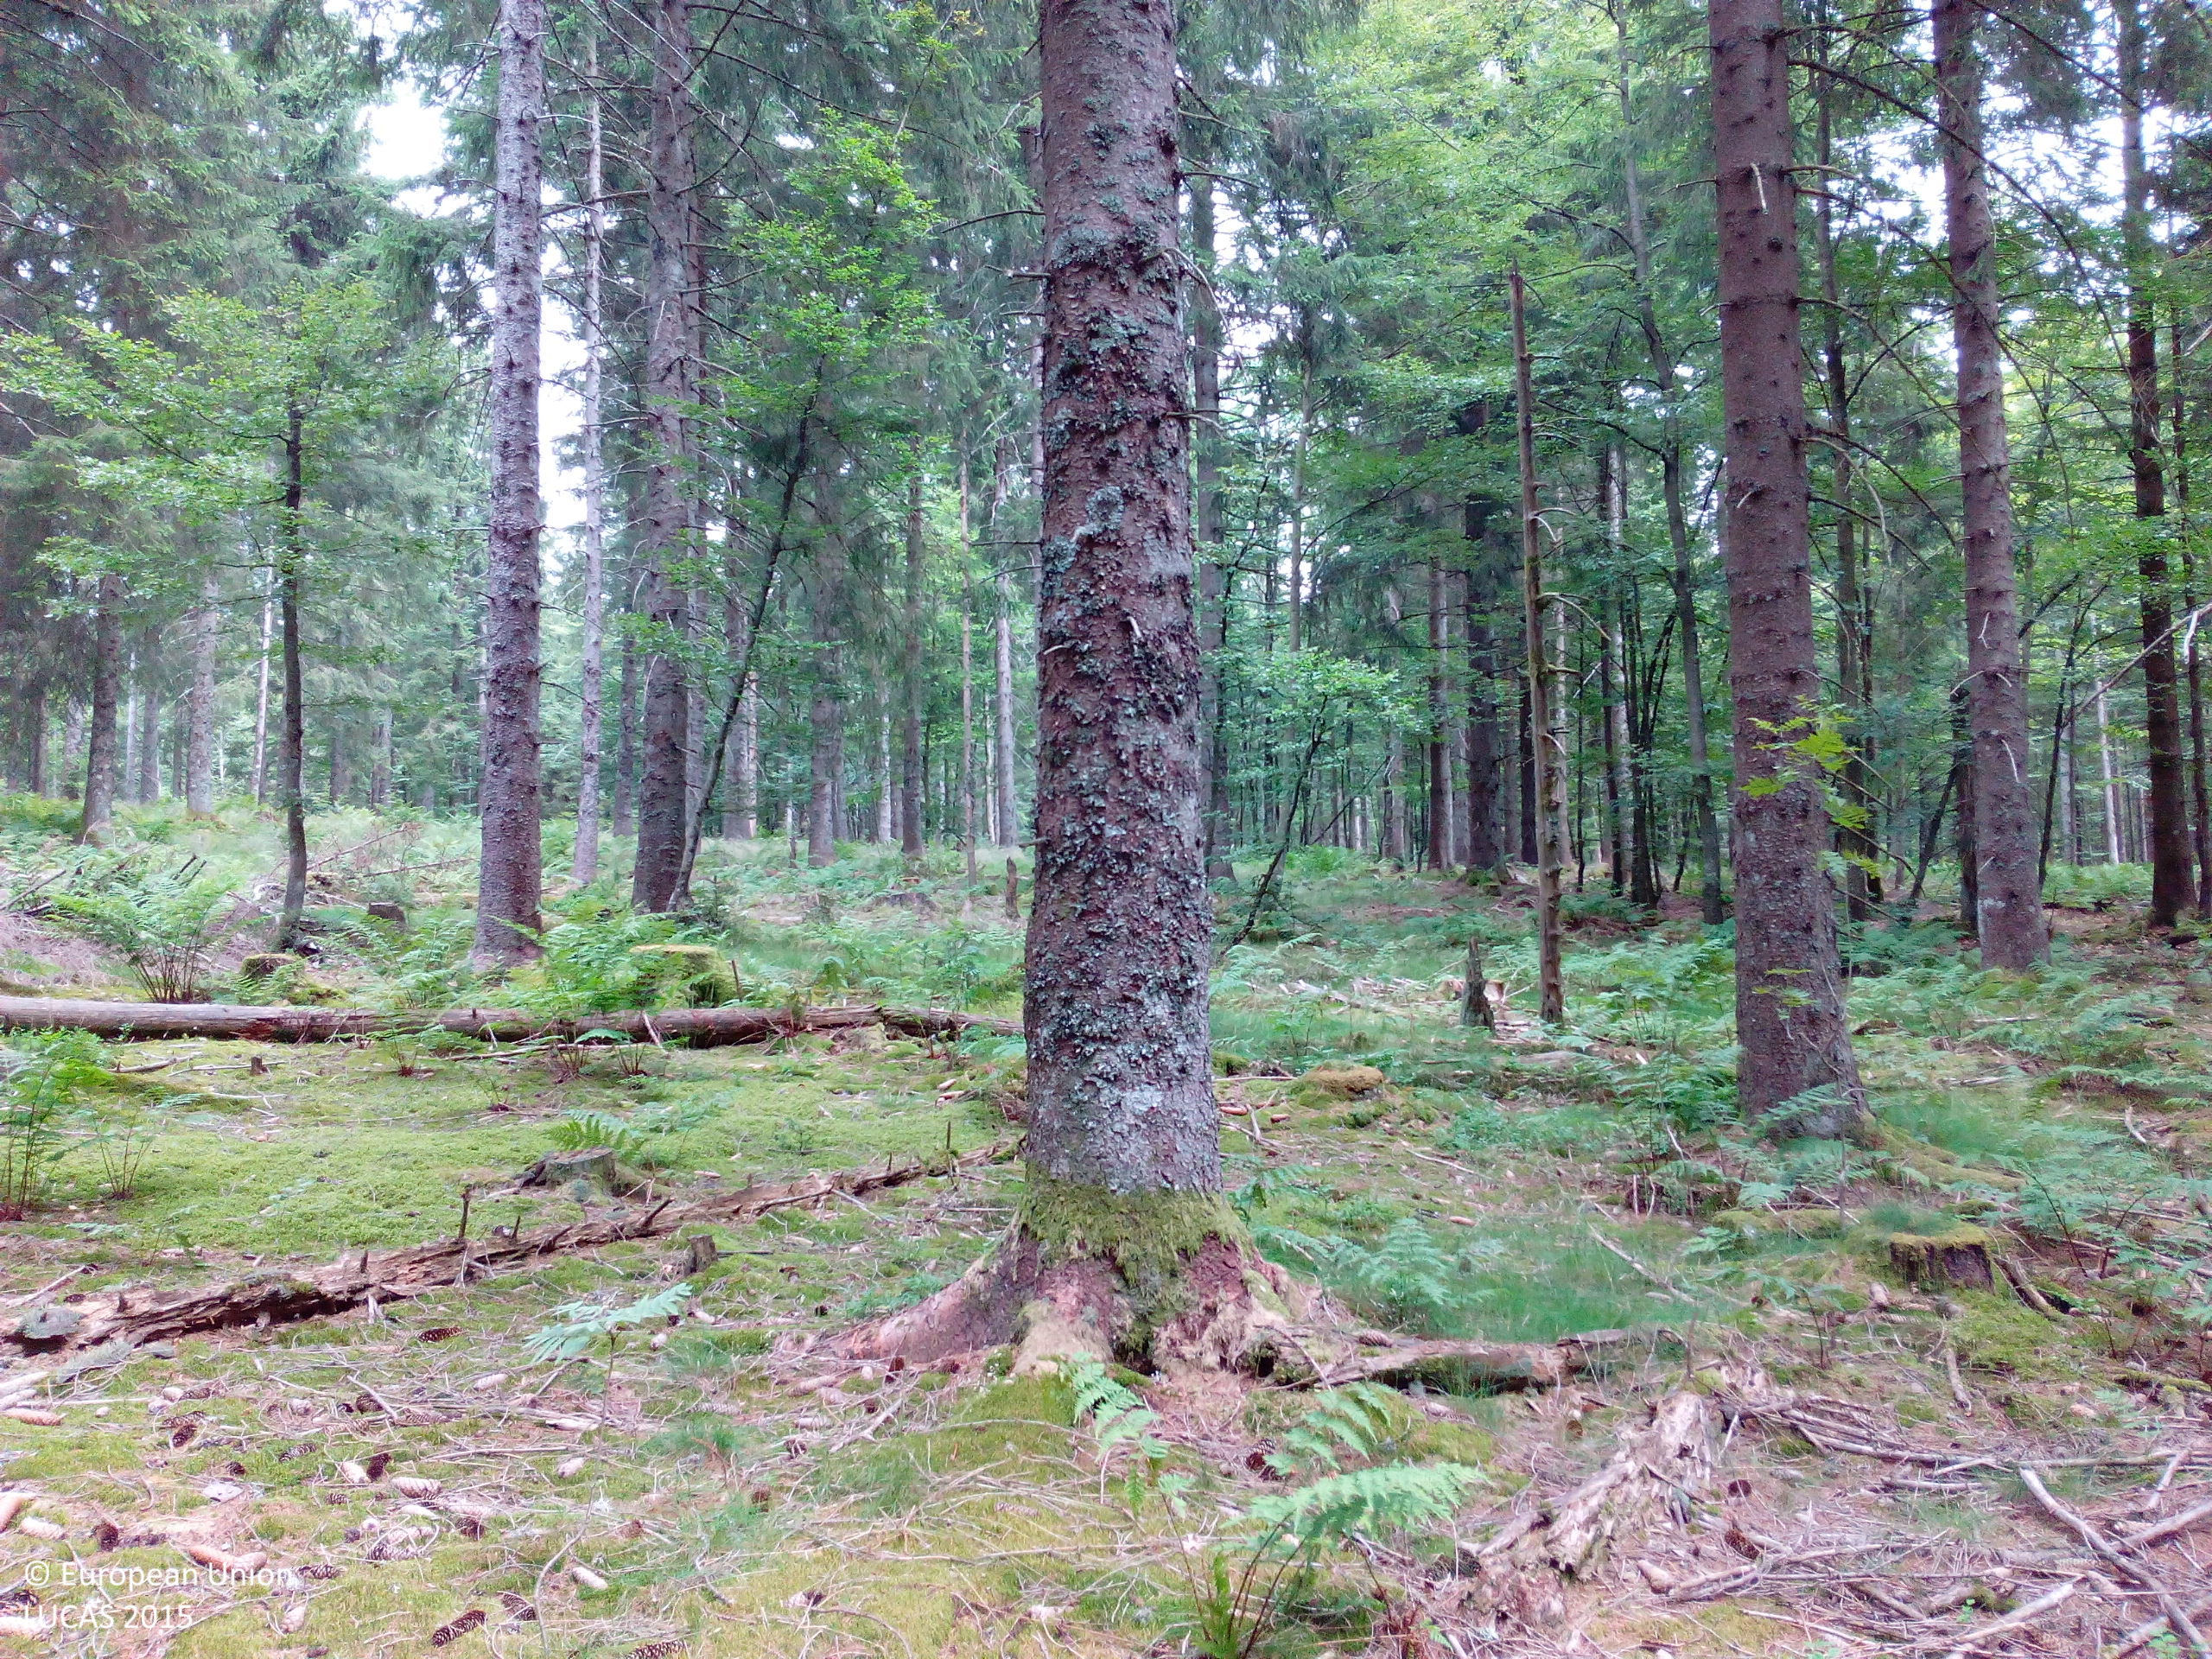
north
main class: Woodland
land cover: Spruce dominated coniferous woodland
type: hemiboreal forest and nemoral coniferous forest and mixed broadleaved-coniferous forest
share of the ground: 50 - 75 %
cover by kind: coniferous forest trees 65 %, herbaceous plants 15 %, lichens and mosses 10 %, broadleaved forest trees 5 %, shrubs 5 %
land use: Forestry
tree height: > 5 m
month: August
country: DE
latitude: 48.1178
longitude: 8.1338
